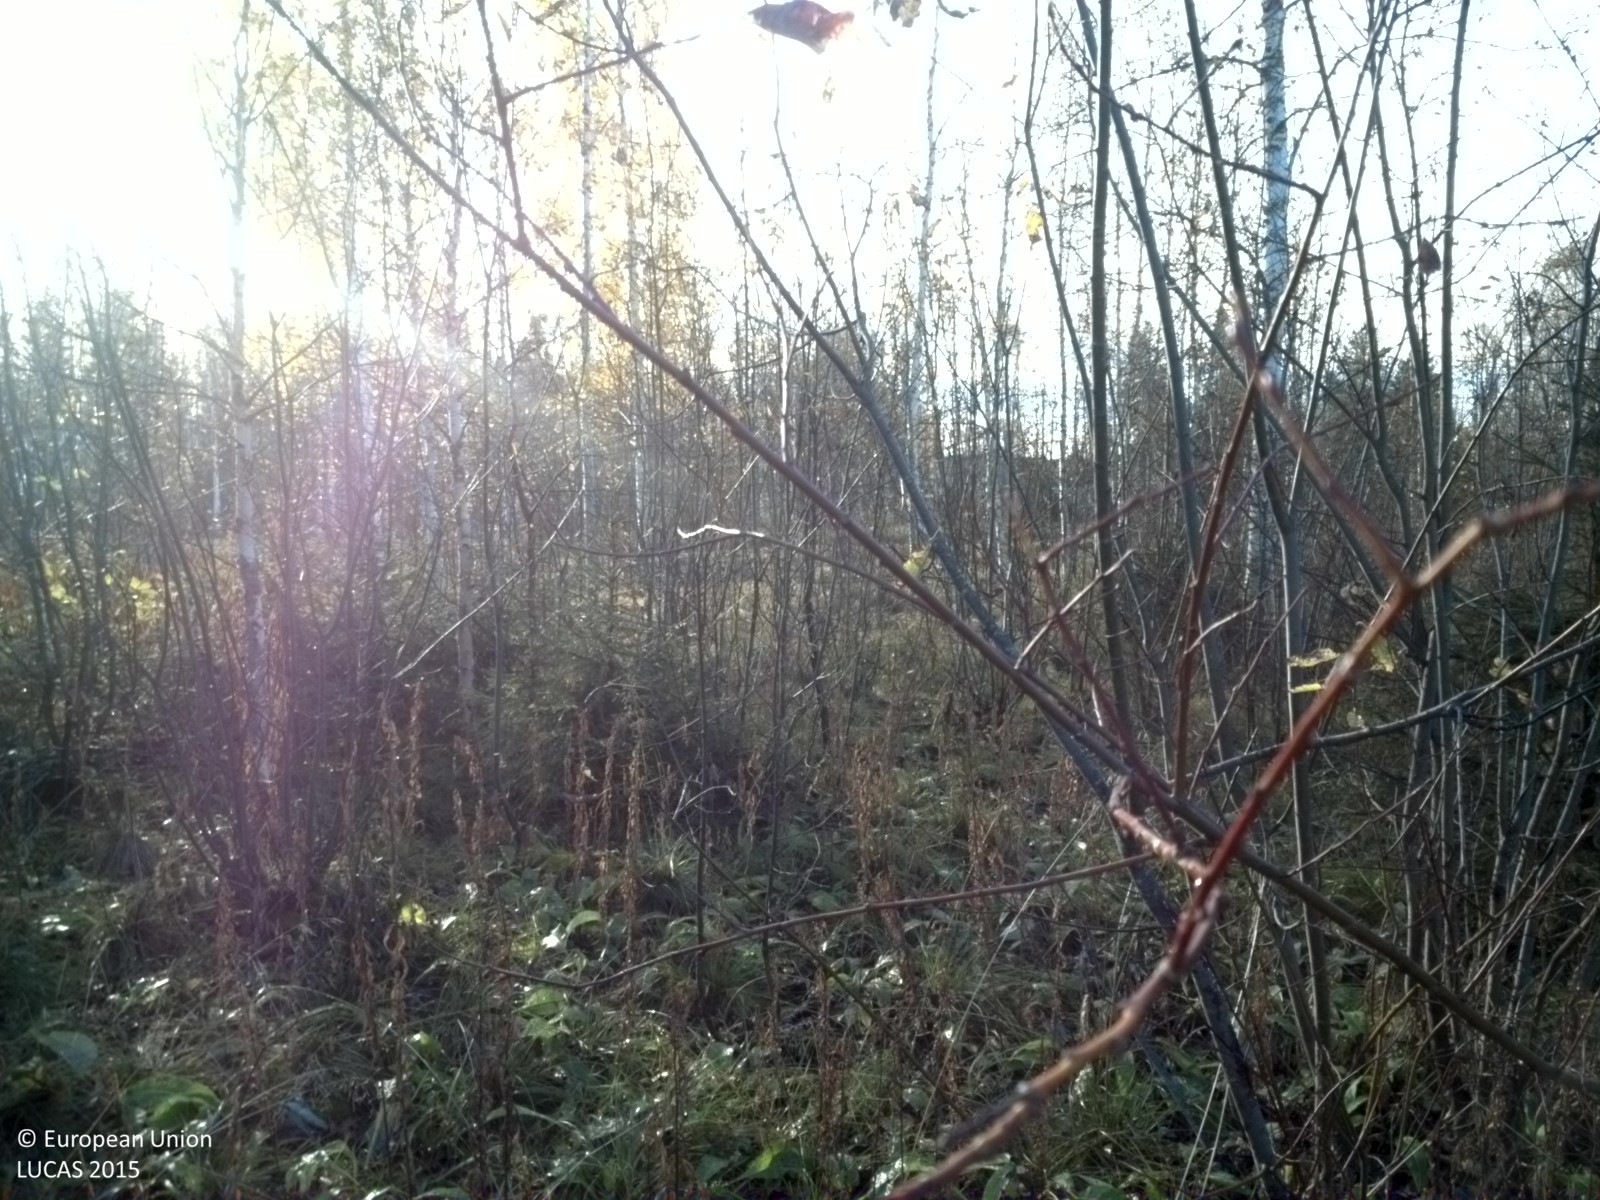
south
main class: Woodland
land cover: Broadleaved woodland
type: non-riverine alder, birch or aspen forest
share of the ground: 50 - 75 %
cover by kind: broadleaved forest trees 55 %, herbaceous plants 35 %, shrubs 10 %
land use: Forestry
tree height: > 5 m
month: October
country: SE
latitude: 65.7412
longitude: 21.4226
